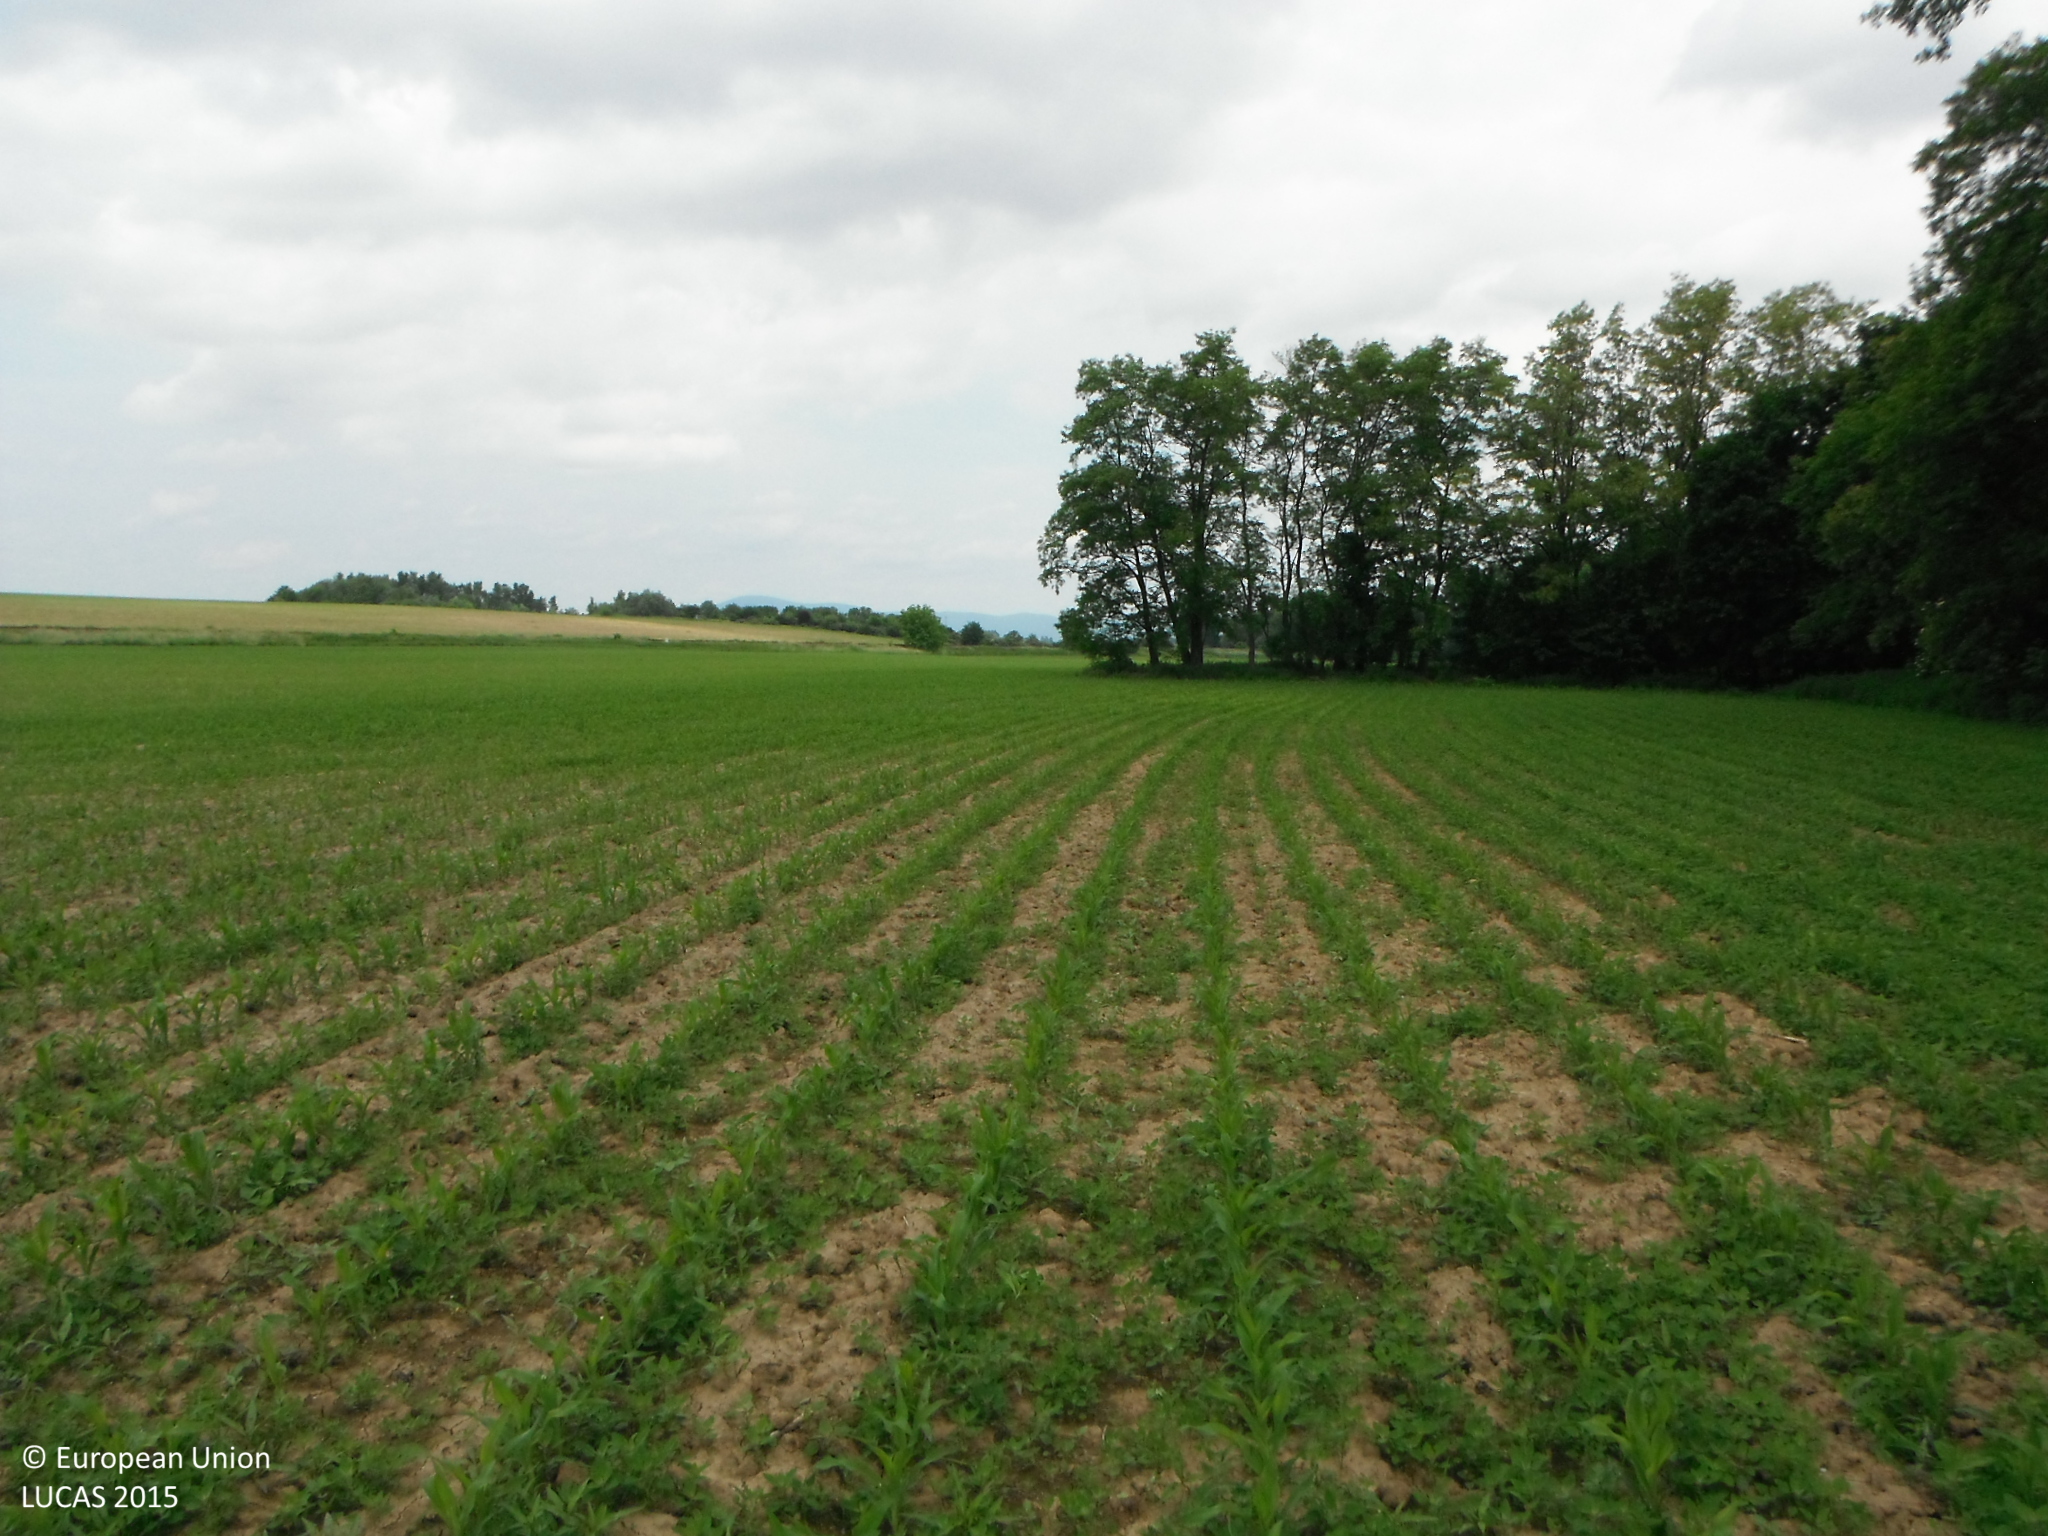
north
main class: Cropland
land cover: Maize
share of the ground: 10 - 25 %
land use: Agriculture (excluding fallow land and kitchen gardens)
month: June
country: SK
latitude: 48.3055
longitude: 18.3338
